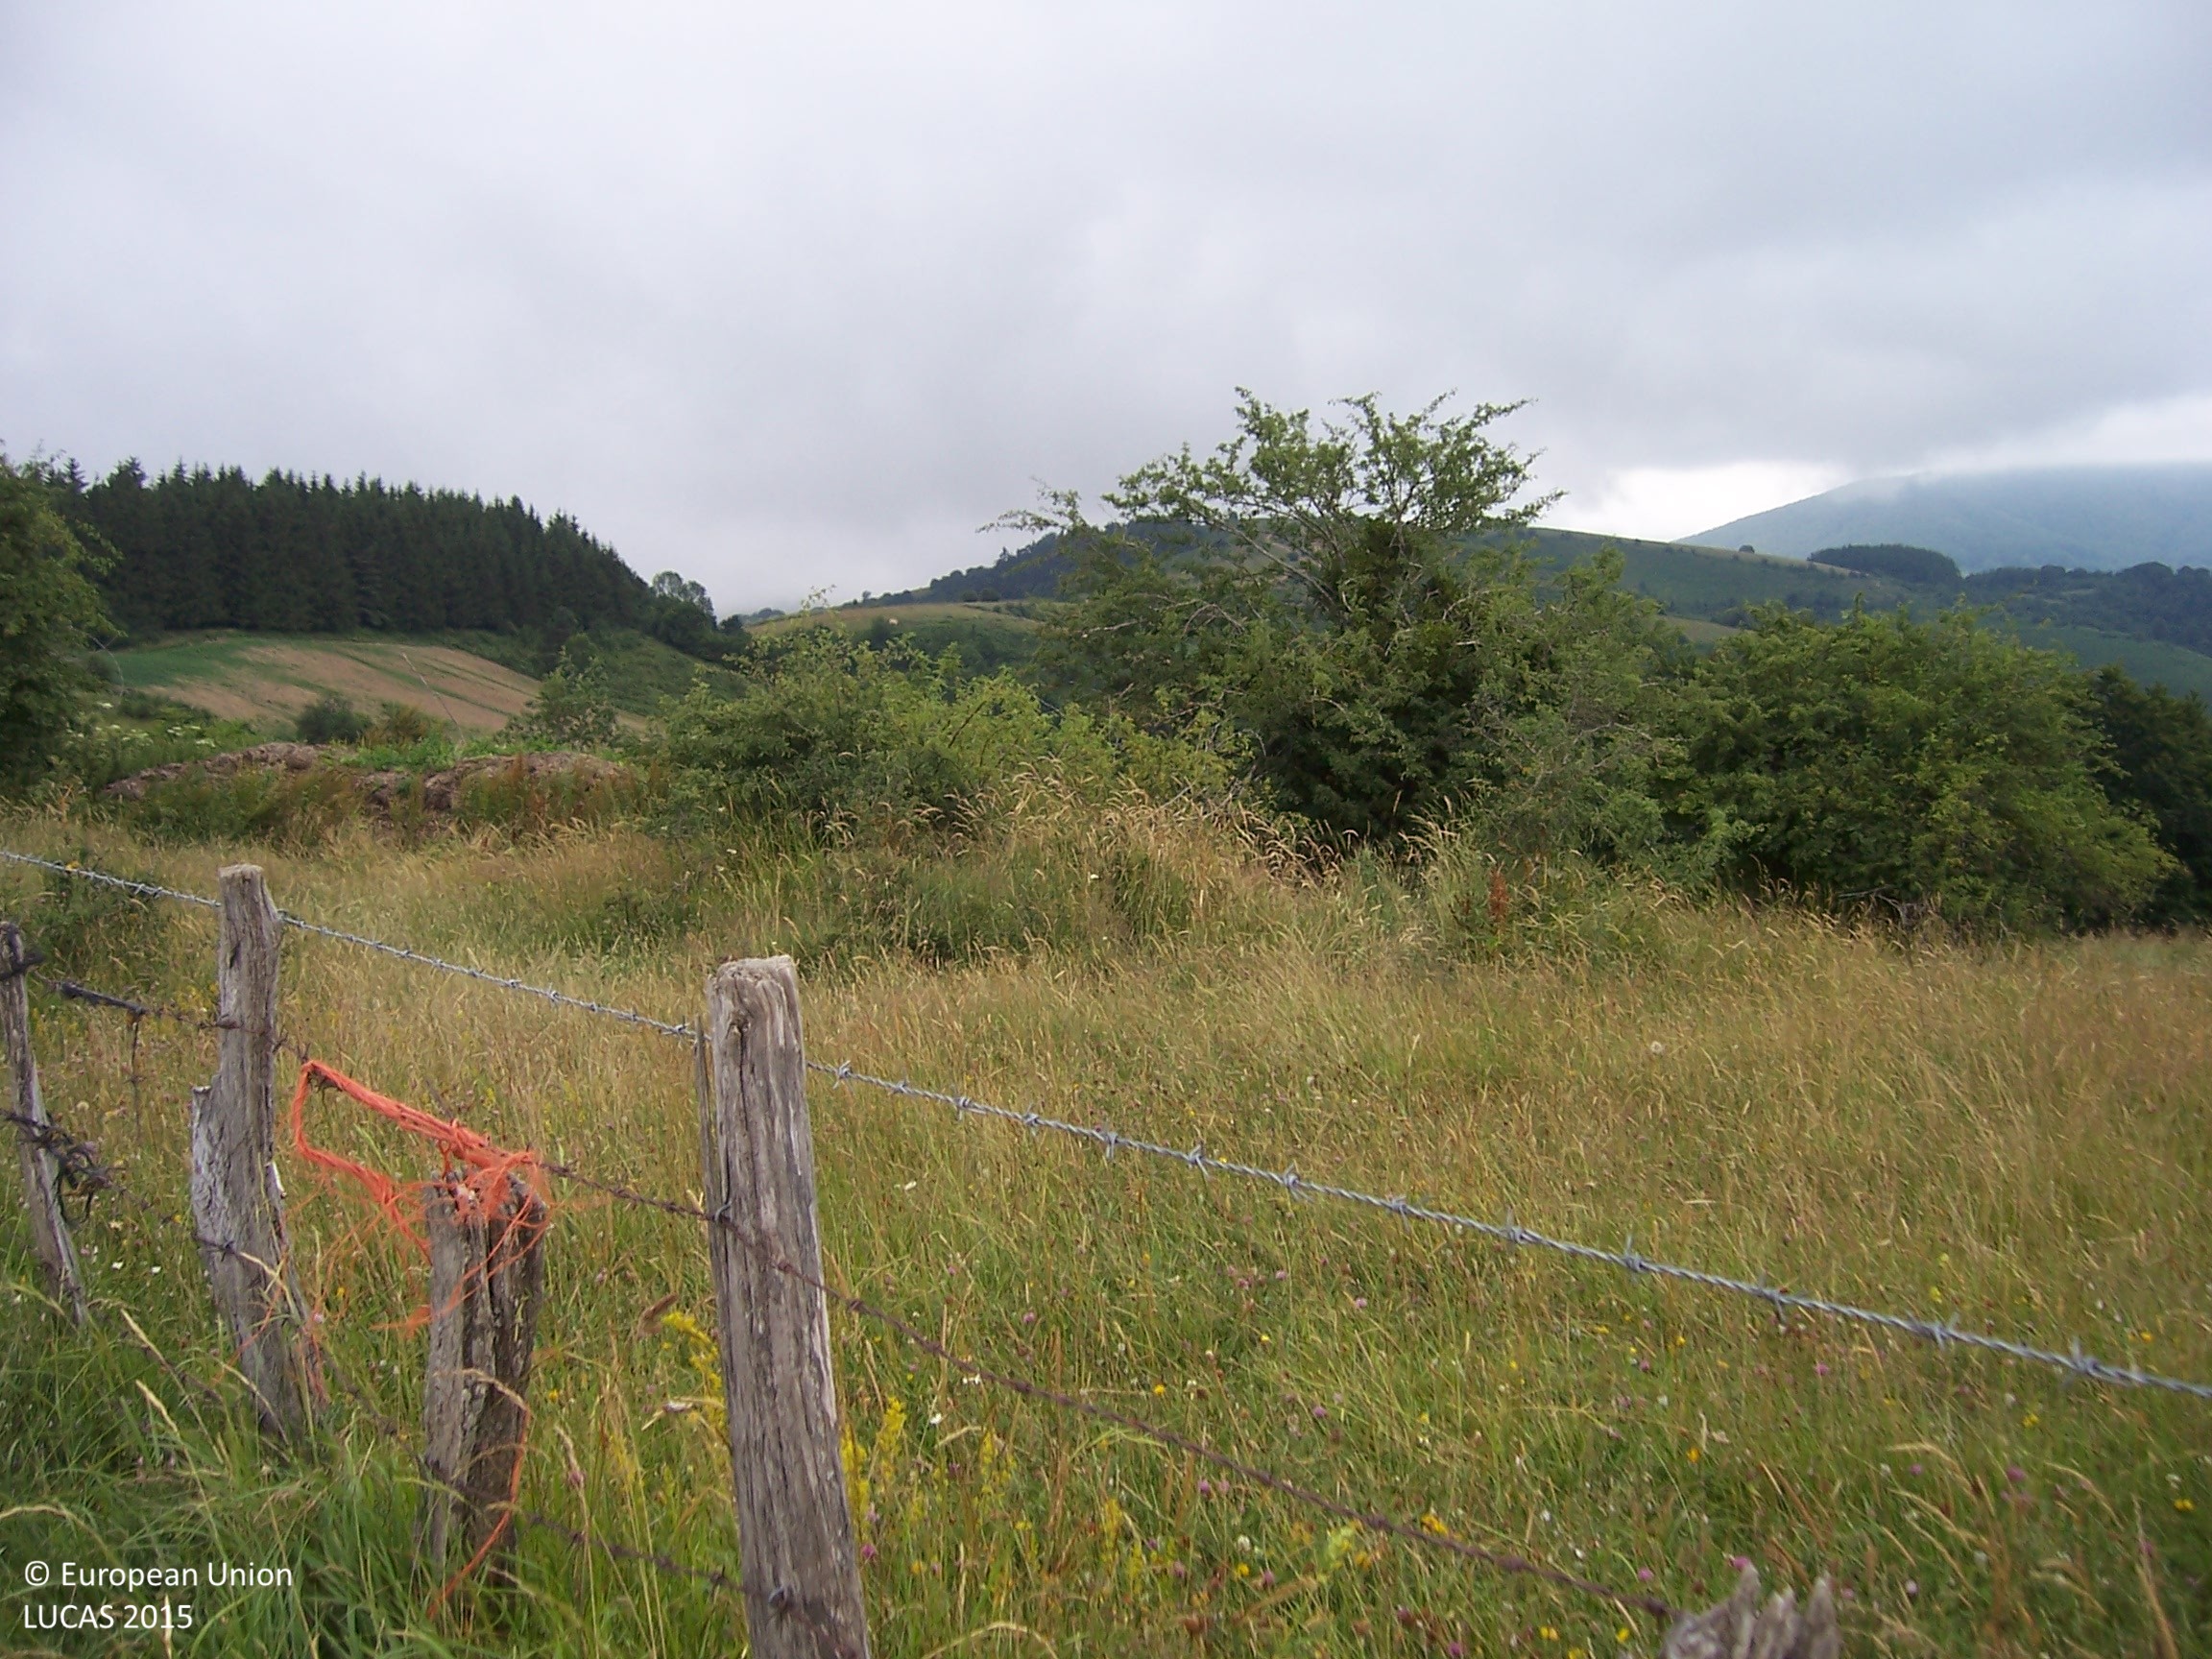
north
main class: Grassland
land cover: Grassland without tree/shrub cover
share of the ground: > 75 %
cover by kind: herbaceous plants 100 %
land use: Agriculture (excluding fallow land and kitchen gardens)
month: July
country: ES
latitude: 42.9663
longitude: -1.3039
